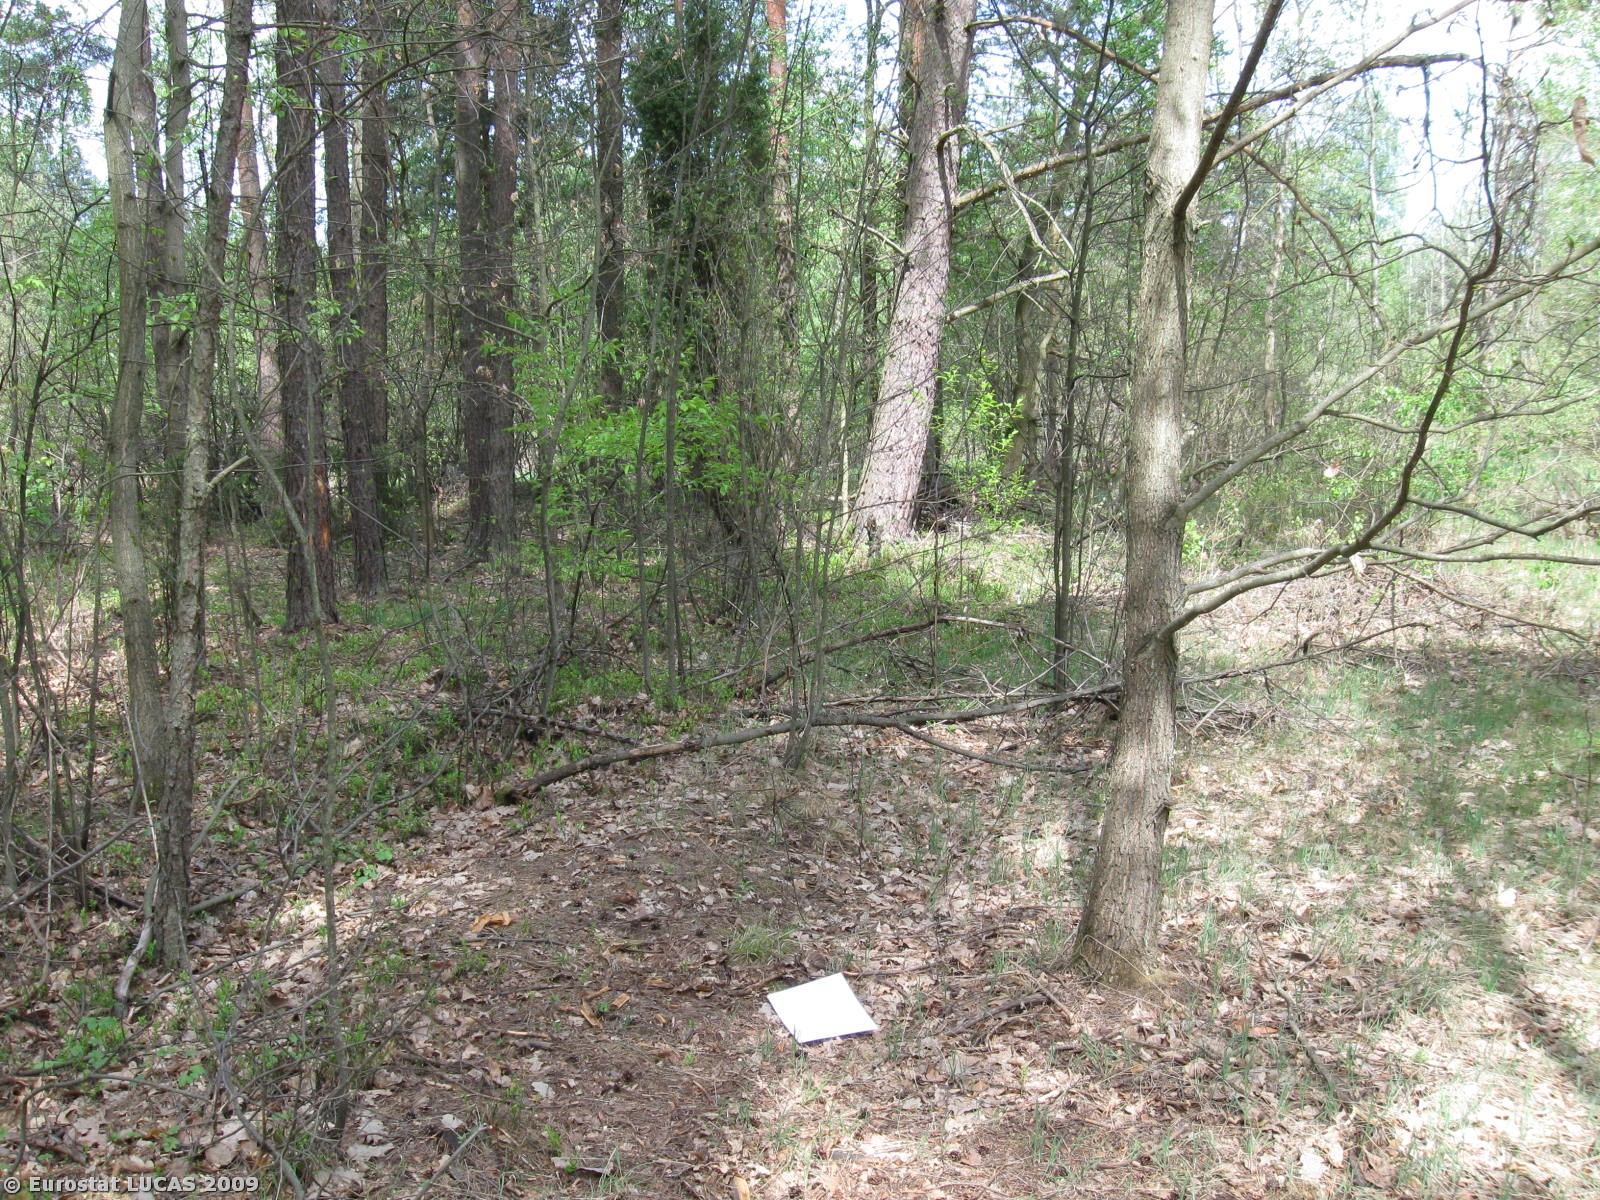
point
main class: Woodland
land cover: Mixed woodland
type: hemiboreal forest and nemoral coniferous forest and mixed broadleaved-coniferous forest
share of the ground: > 75 %
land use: Forestry
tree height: > 5 m
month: May
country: PL
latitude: 51.1651
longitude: 20.5210
